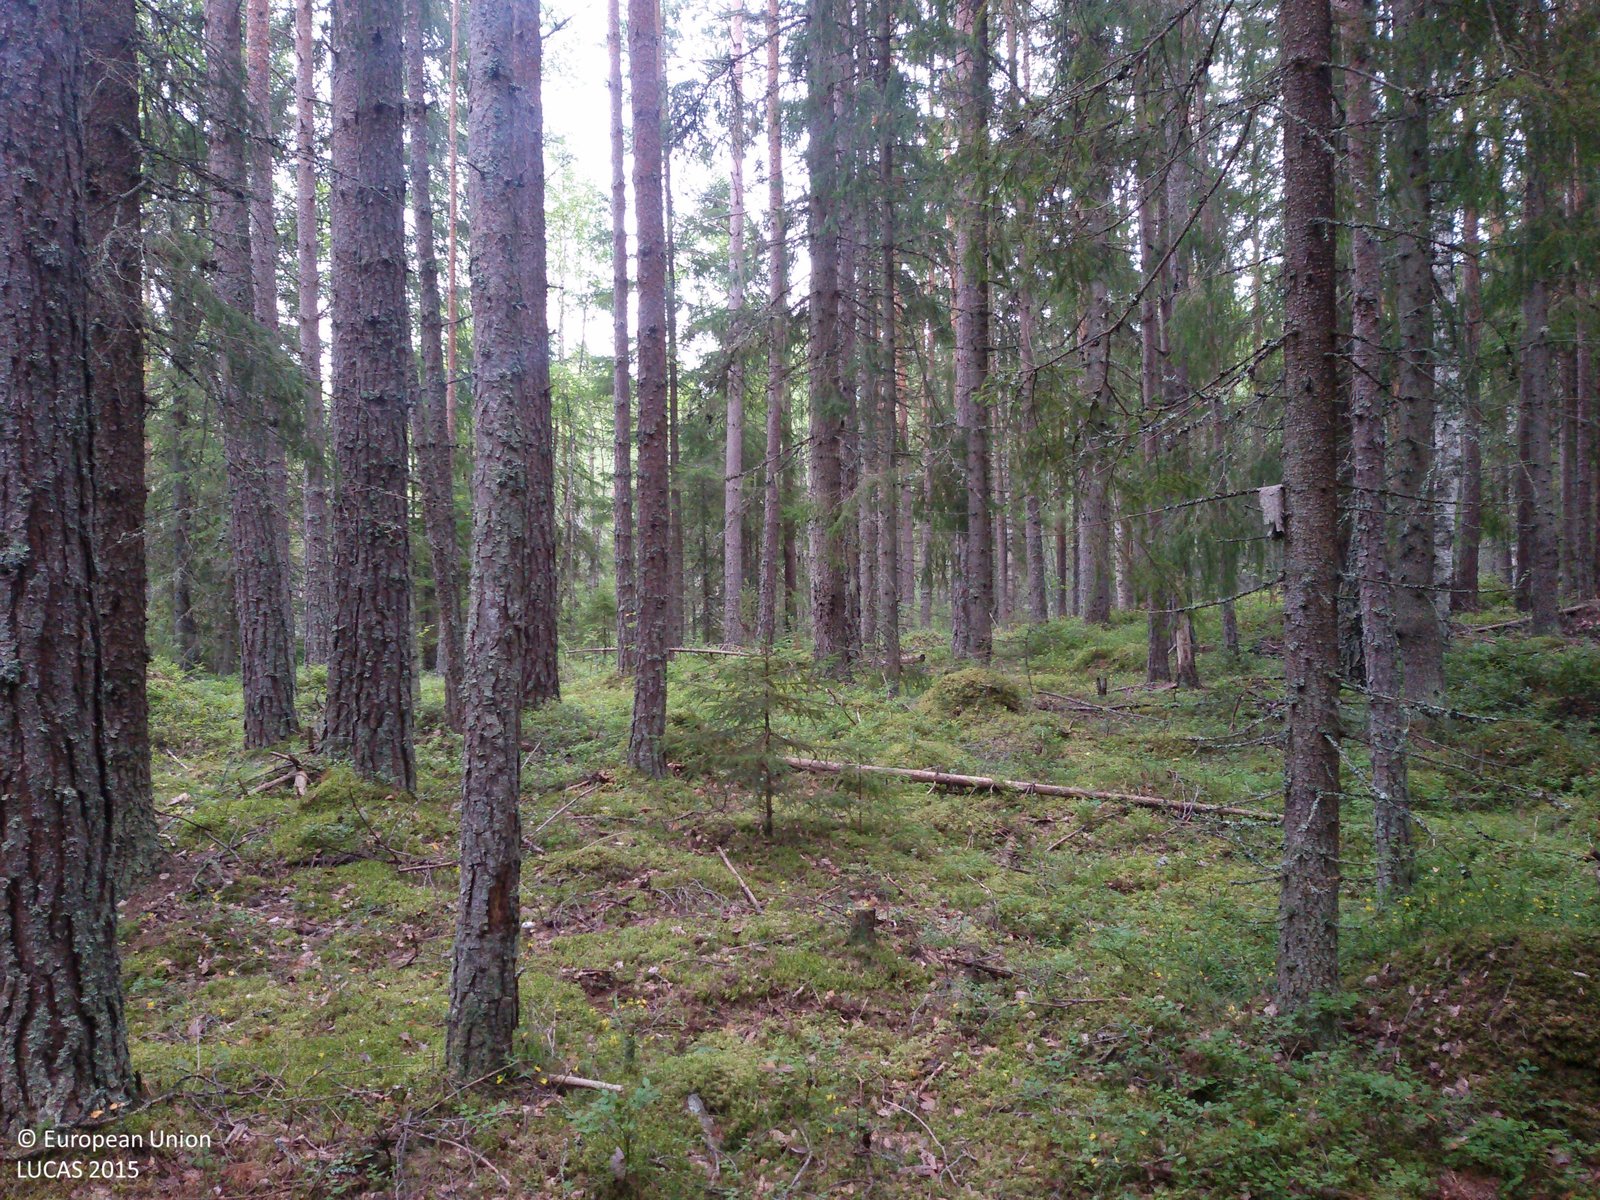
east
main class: Woodland
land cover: Spruce dominated mixed woodland
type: boreal forest
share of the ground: > 75 %
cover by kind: coniferous forest trees 55 %, broadleaved forest trees 30 %, lichens and mosses 10 %, herbaceous plants 5 %
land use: Forestry
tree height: > 5 m
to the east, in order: Spruce dominated mixed woodland; Spruce dominated coniferous woodland
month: August
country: SE
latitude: 60.6574
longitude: 16.6289
